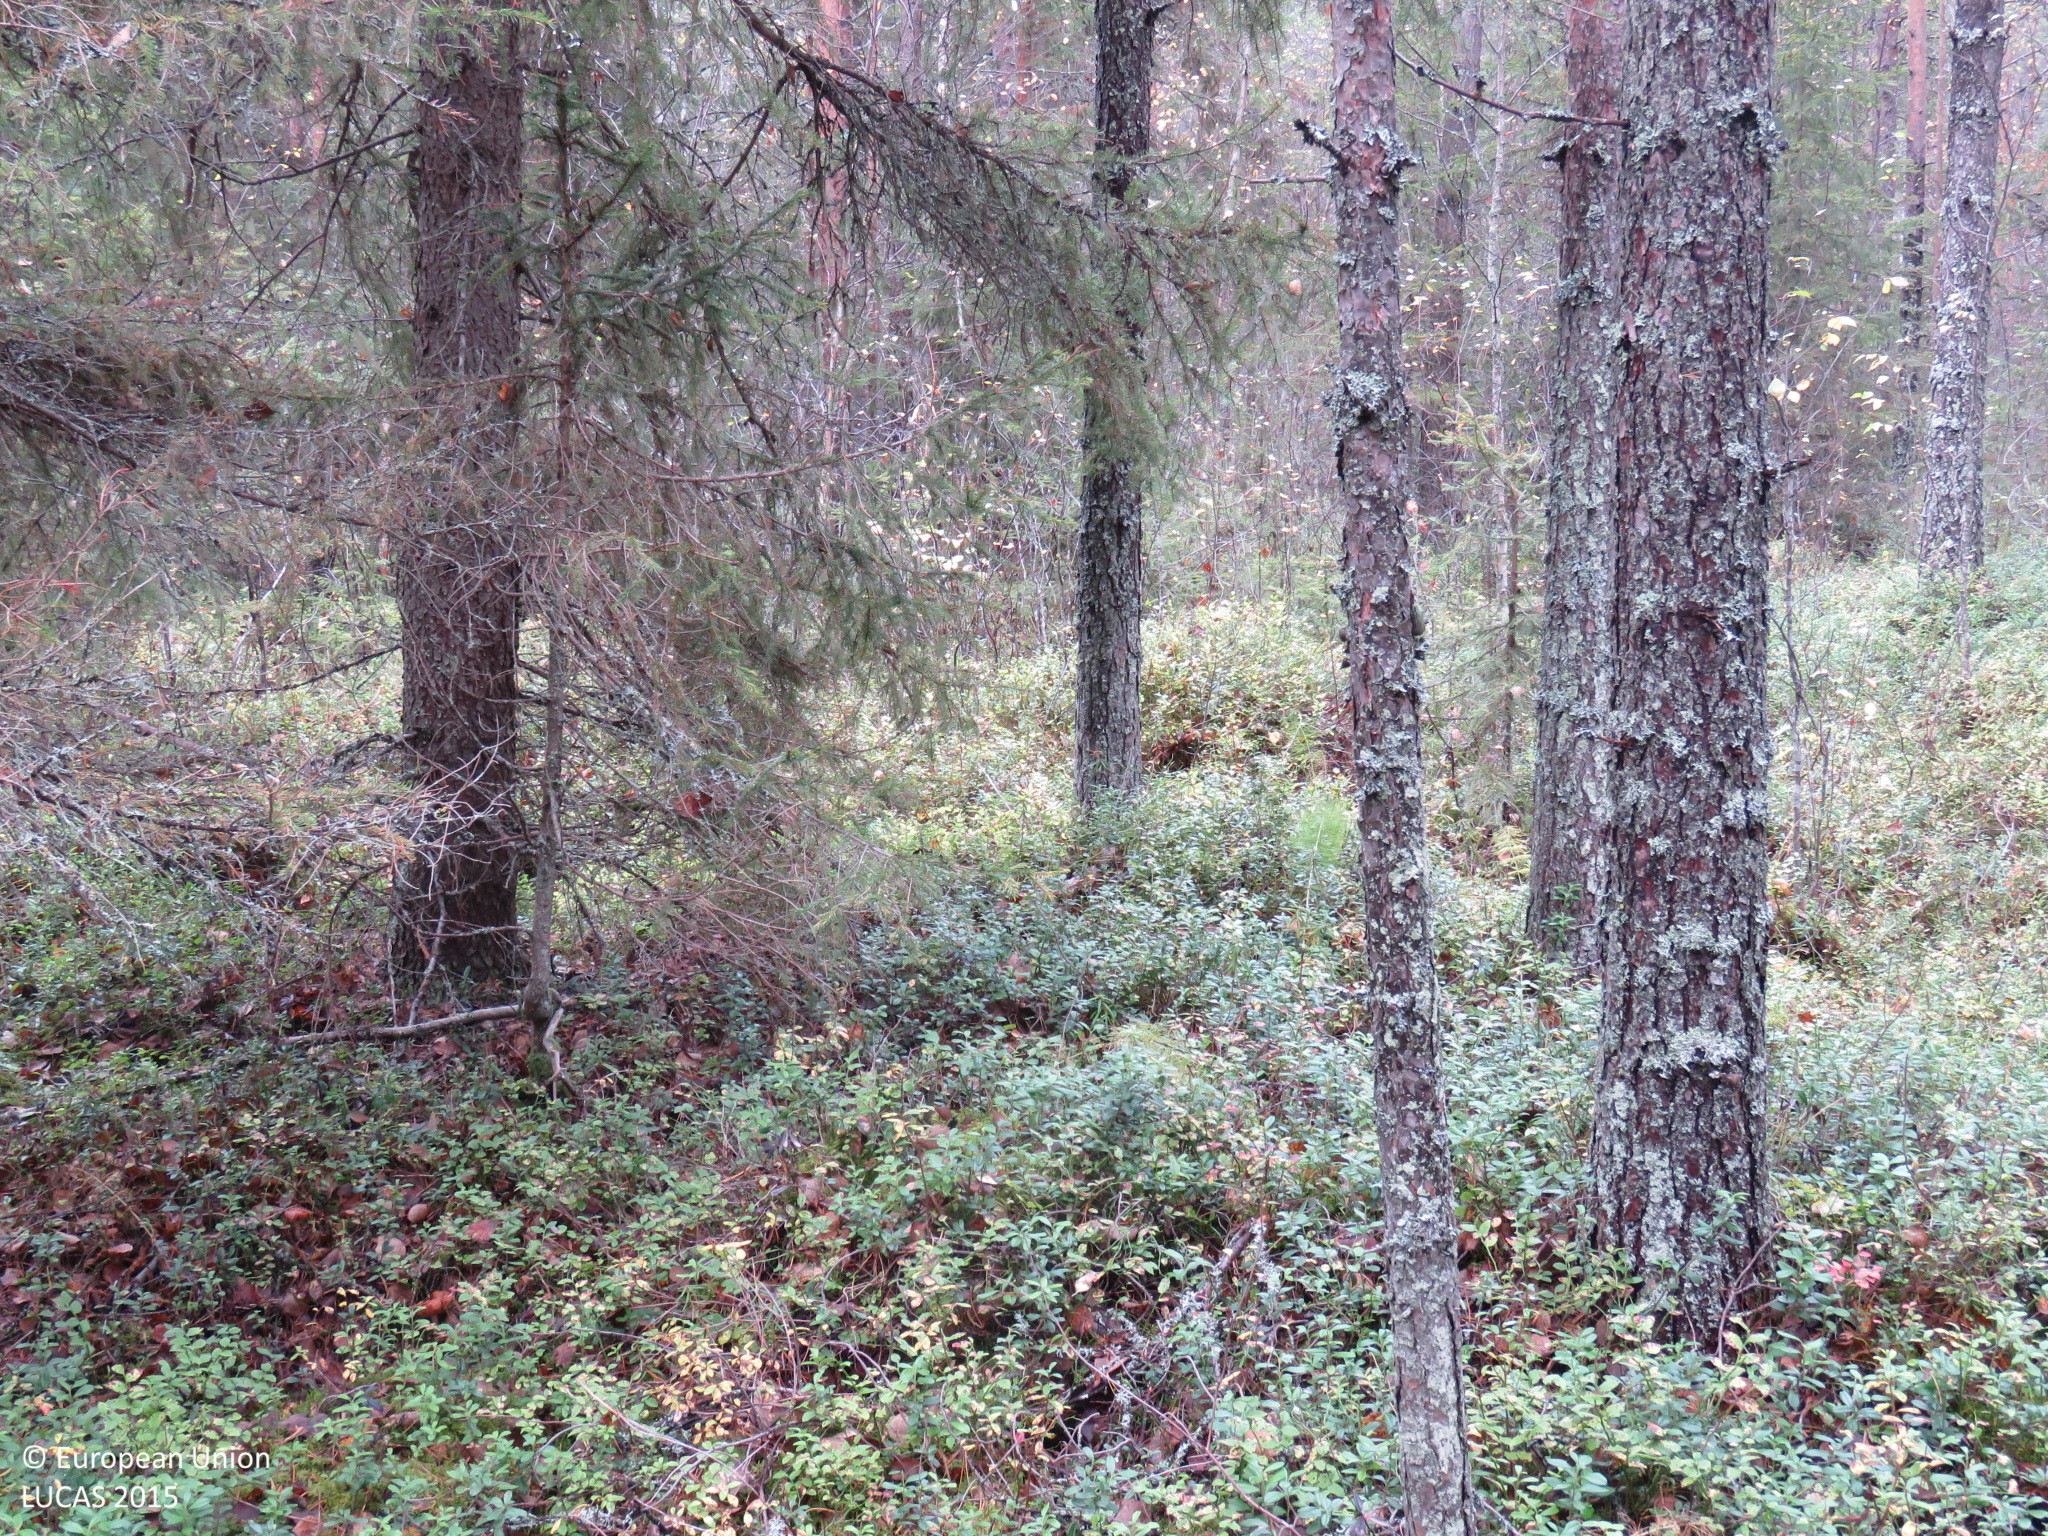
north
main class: Woodland
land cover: Other coniferous woodland
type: boreal forest
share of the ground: > 75 %
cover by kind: coniferous forest trees 70 %, shrubs 15 %, broadleaved forest trees 10 %, lichens and mosses 5 %
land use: Forestry
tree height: > 5 m
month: September
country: FI
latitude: 64.9528
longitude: 27.0377
